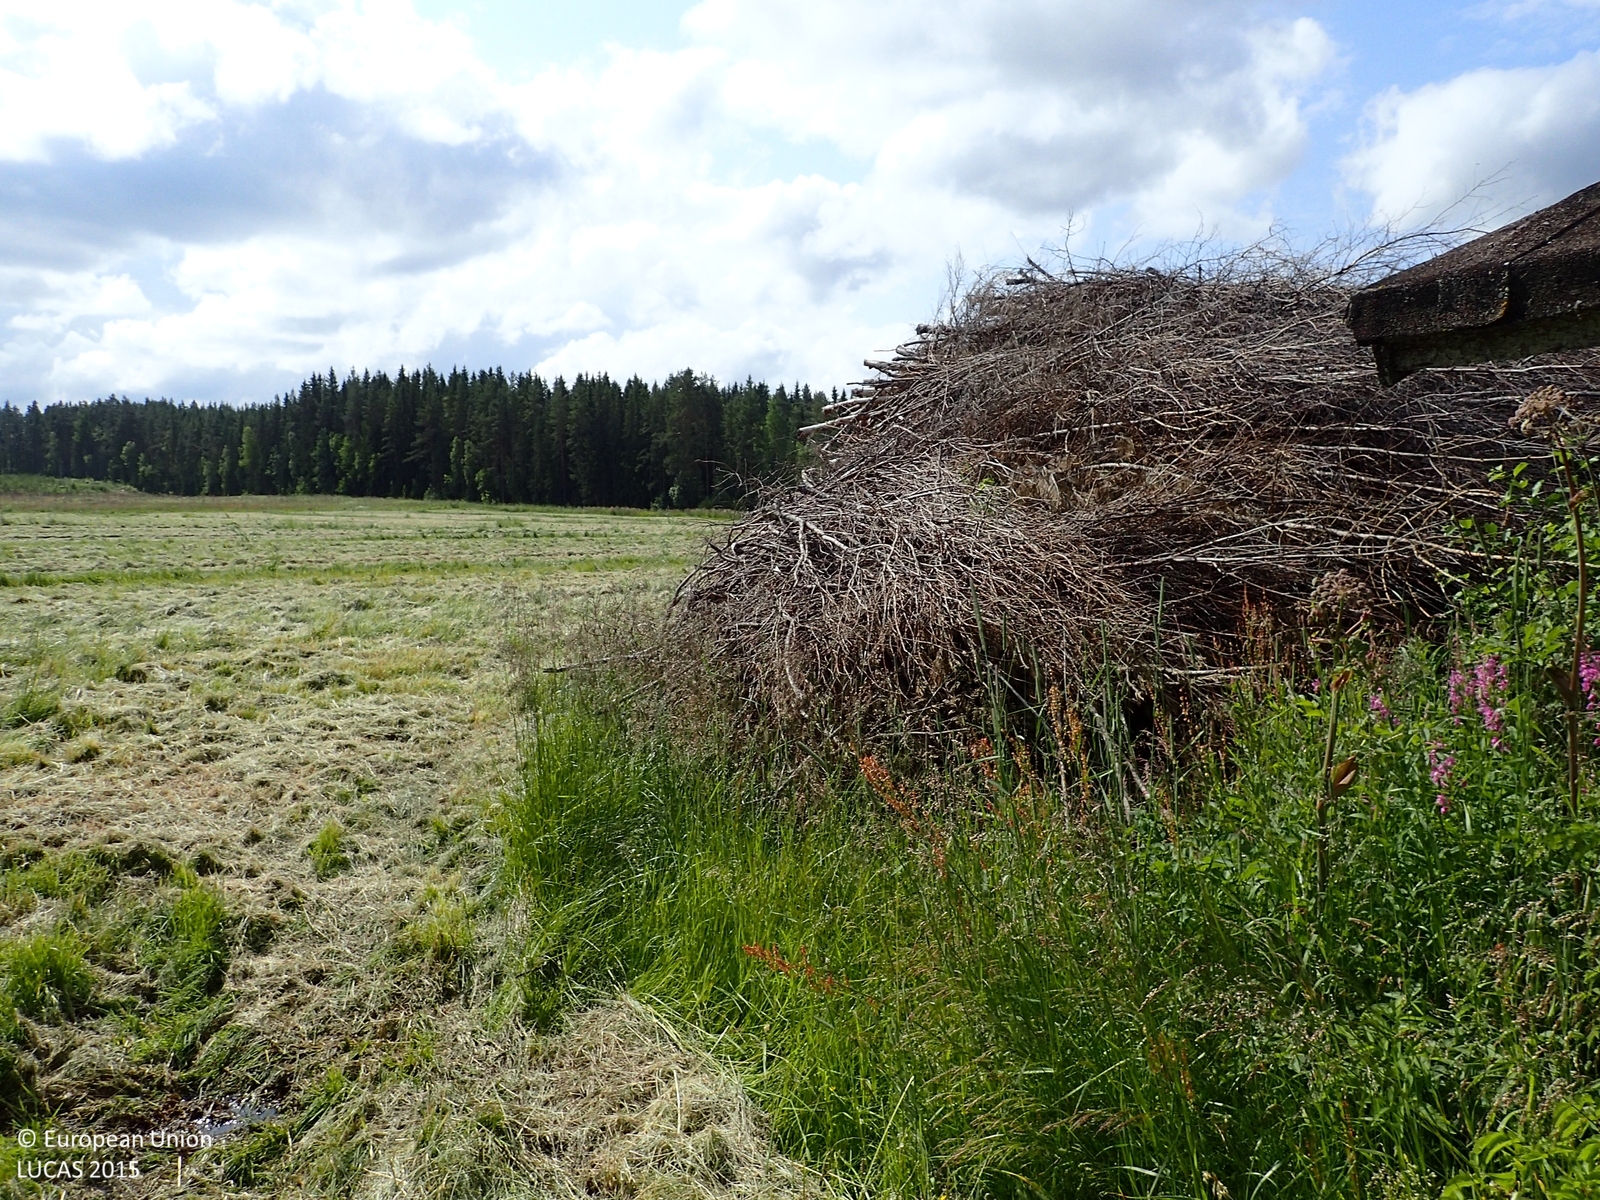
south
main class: Cropland
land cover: Temporary grasslands
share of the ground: > 75 %
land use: Agriculture (excluding fallow land and kitchen gardens)
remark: Harvested field
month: July
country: FI
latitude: 62.7585
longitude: 23.6416
